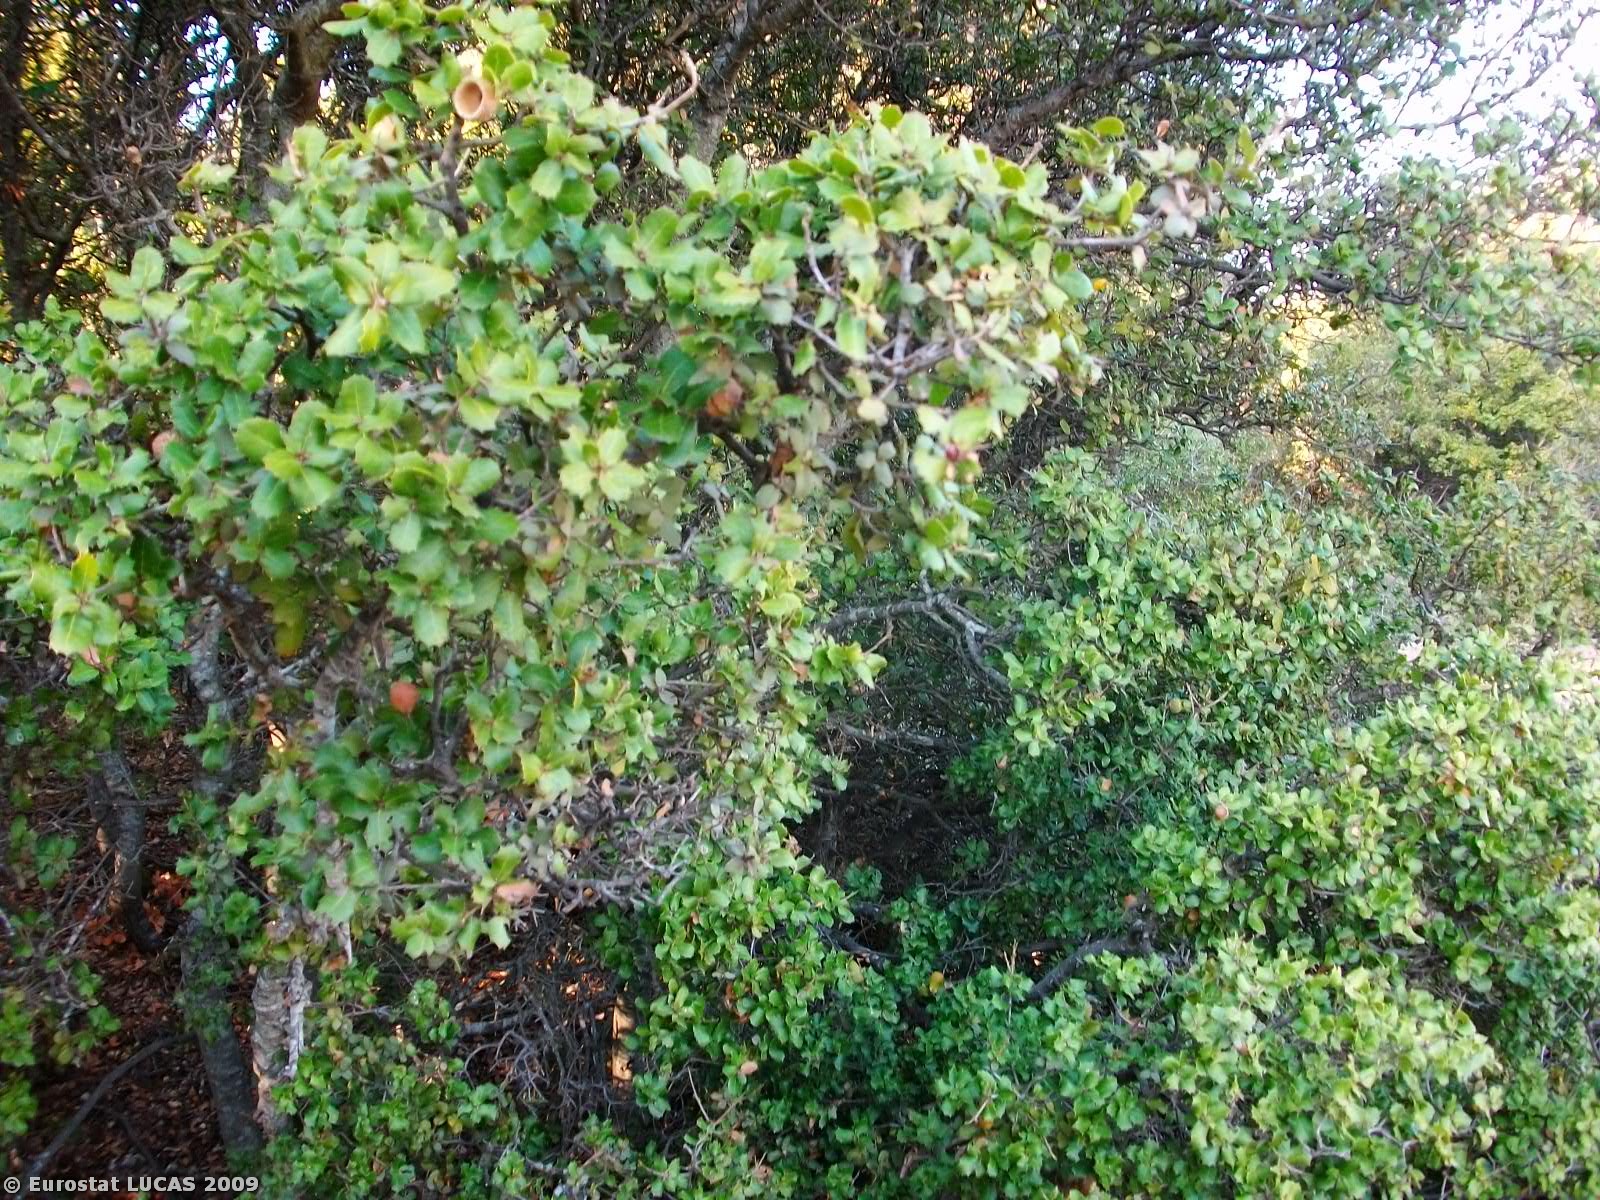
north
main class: Shrubland
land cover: Shrubland with sparse tree cover
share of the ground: > 75 %
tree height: < 5 m
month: October
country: GR
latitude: 40.8933
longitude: 25.7817
